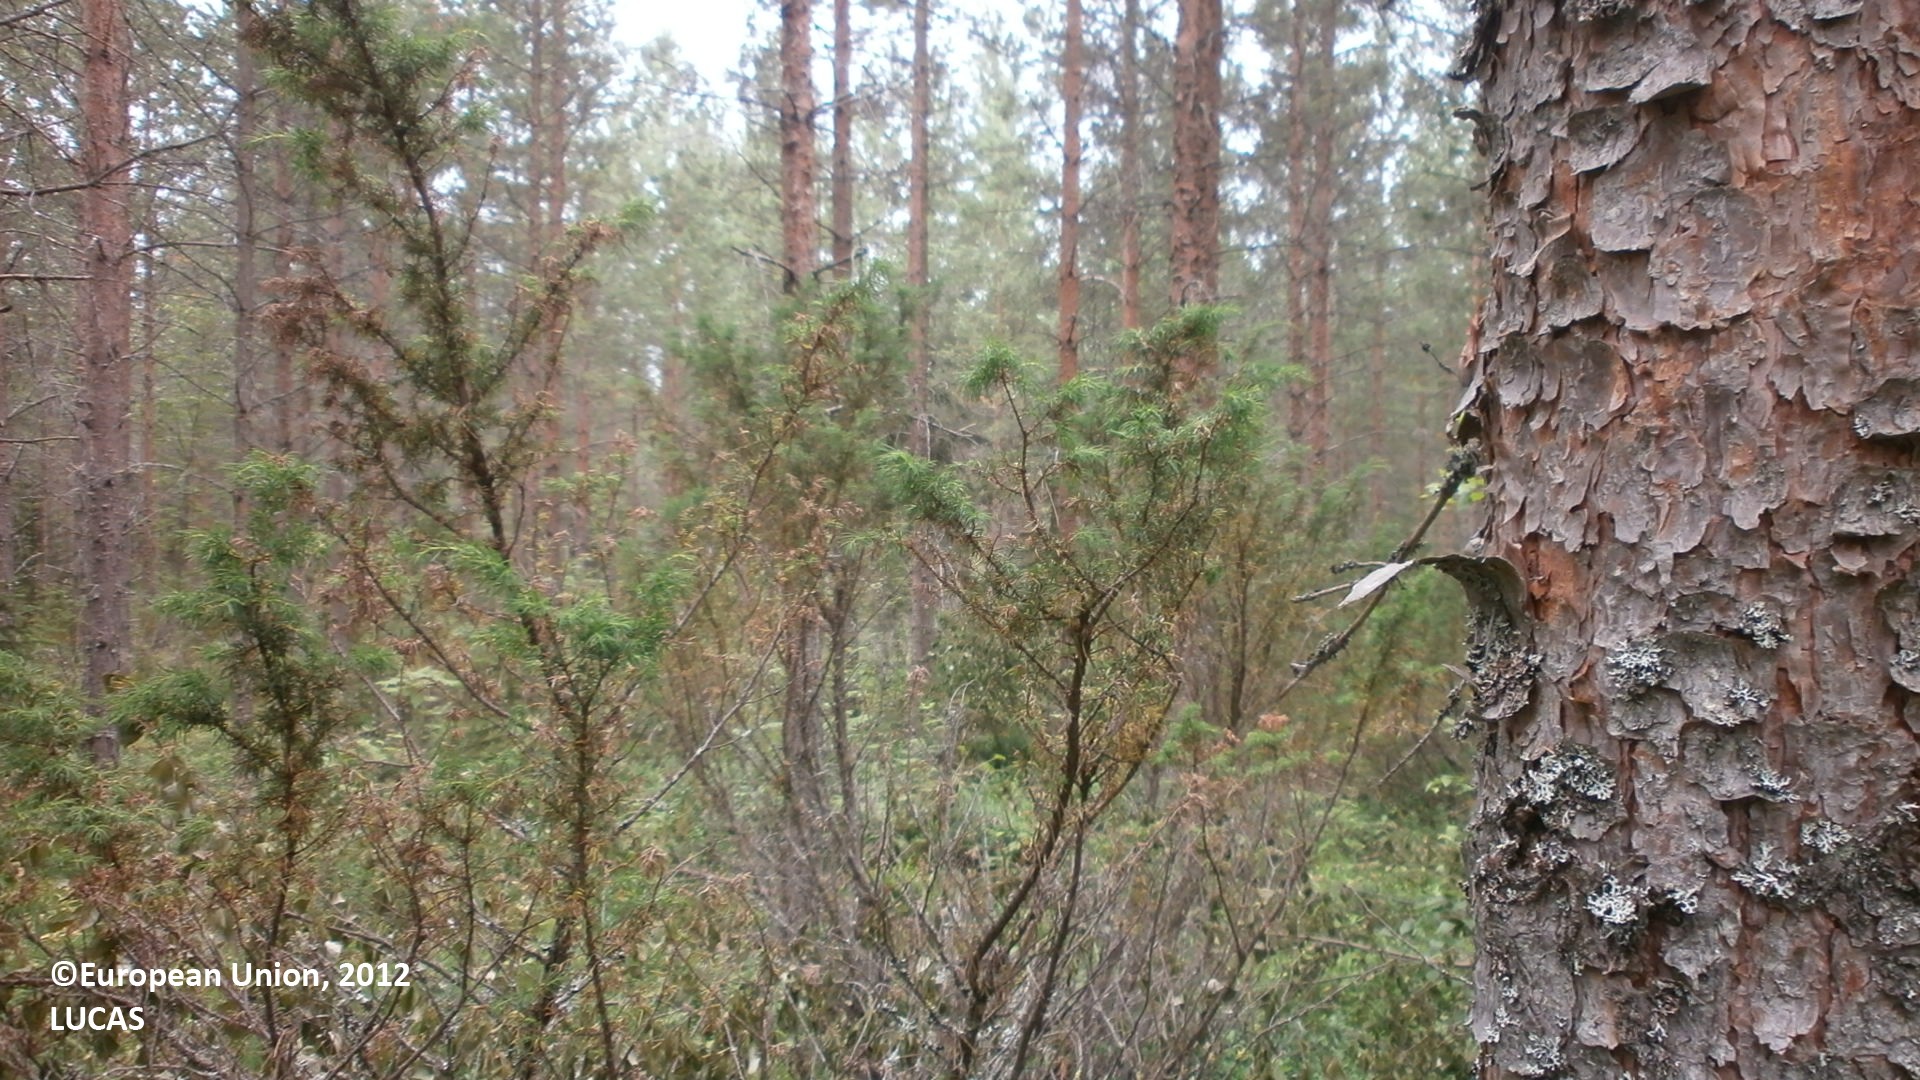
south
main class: Woodland
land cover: Pine dominated coniferous woodland
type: boreal forest
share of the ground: 50 - 75 %
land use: Forestry
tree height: > 5 m
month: July
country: FI
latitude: 64.0203
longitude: 23.9156
